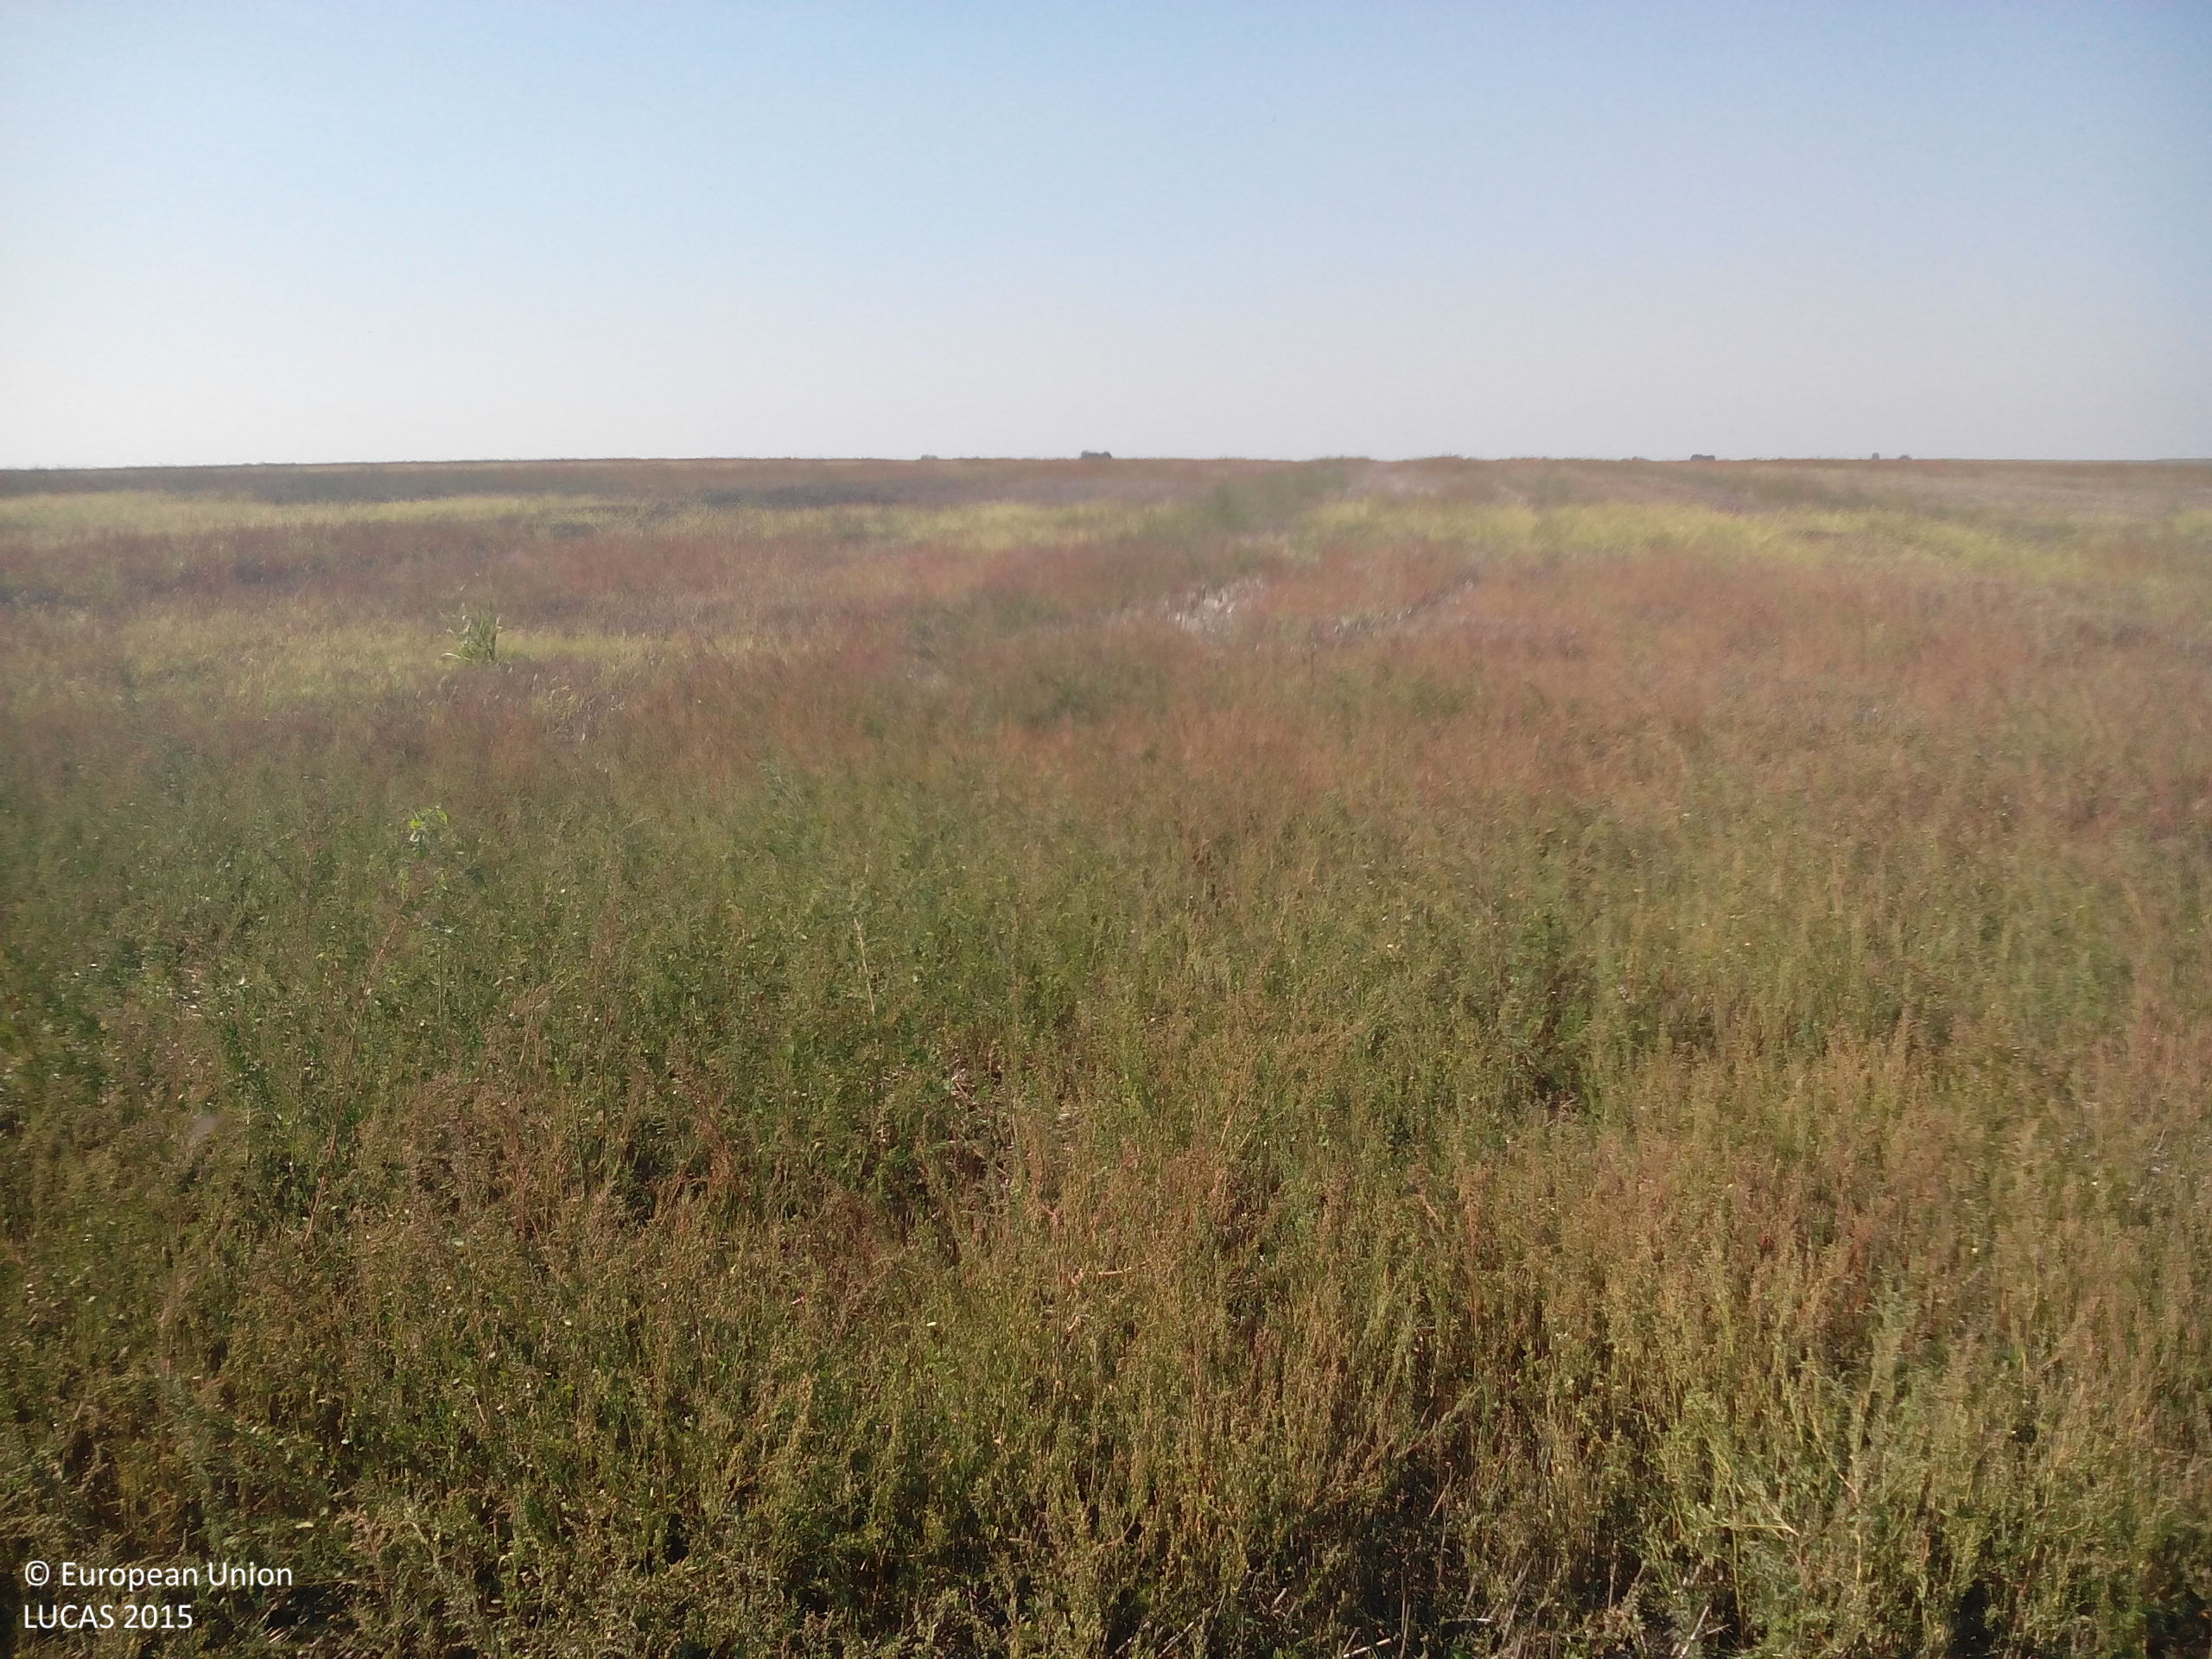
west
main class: Cropland
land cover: Common wheat
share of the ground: 10 - 25 %
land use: Agriculture (excluding fallow land and kitchen gardens)
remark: Harvested field
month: October
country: BG
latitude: 43.5499
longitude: 23.6757
